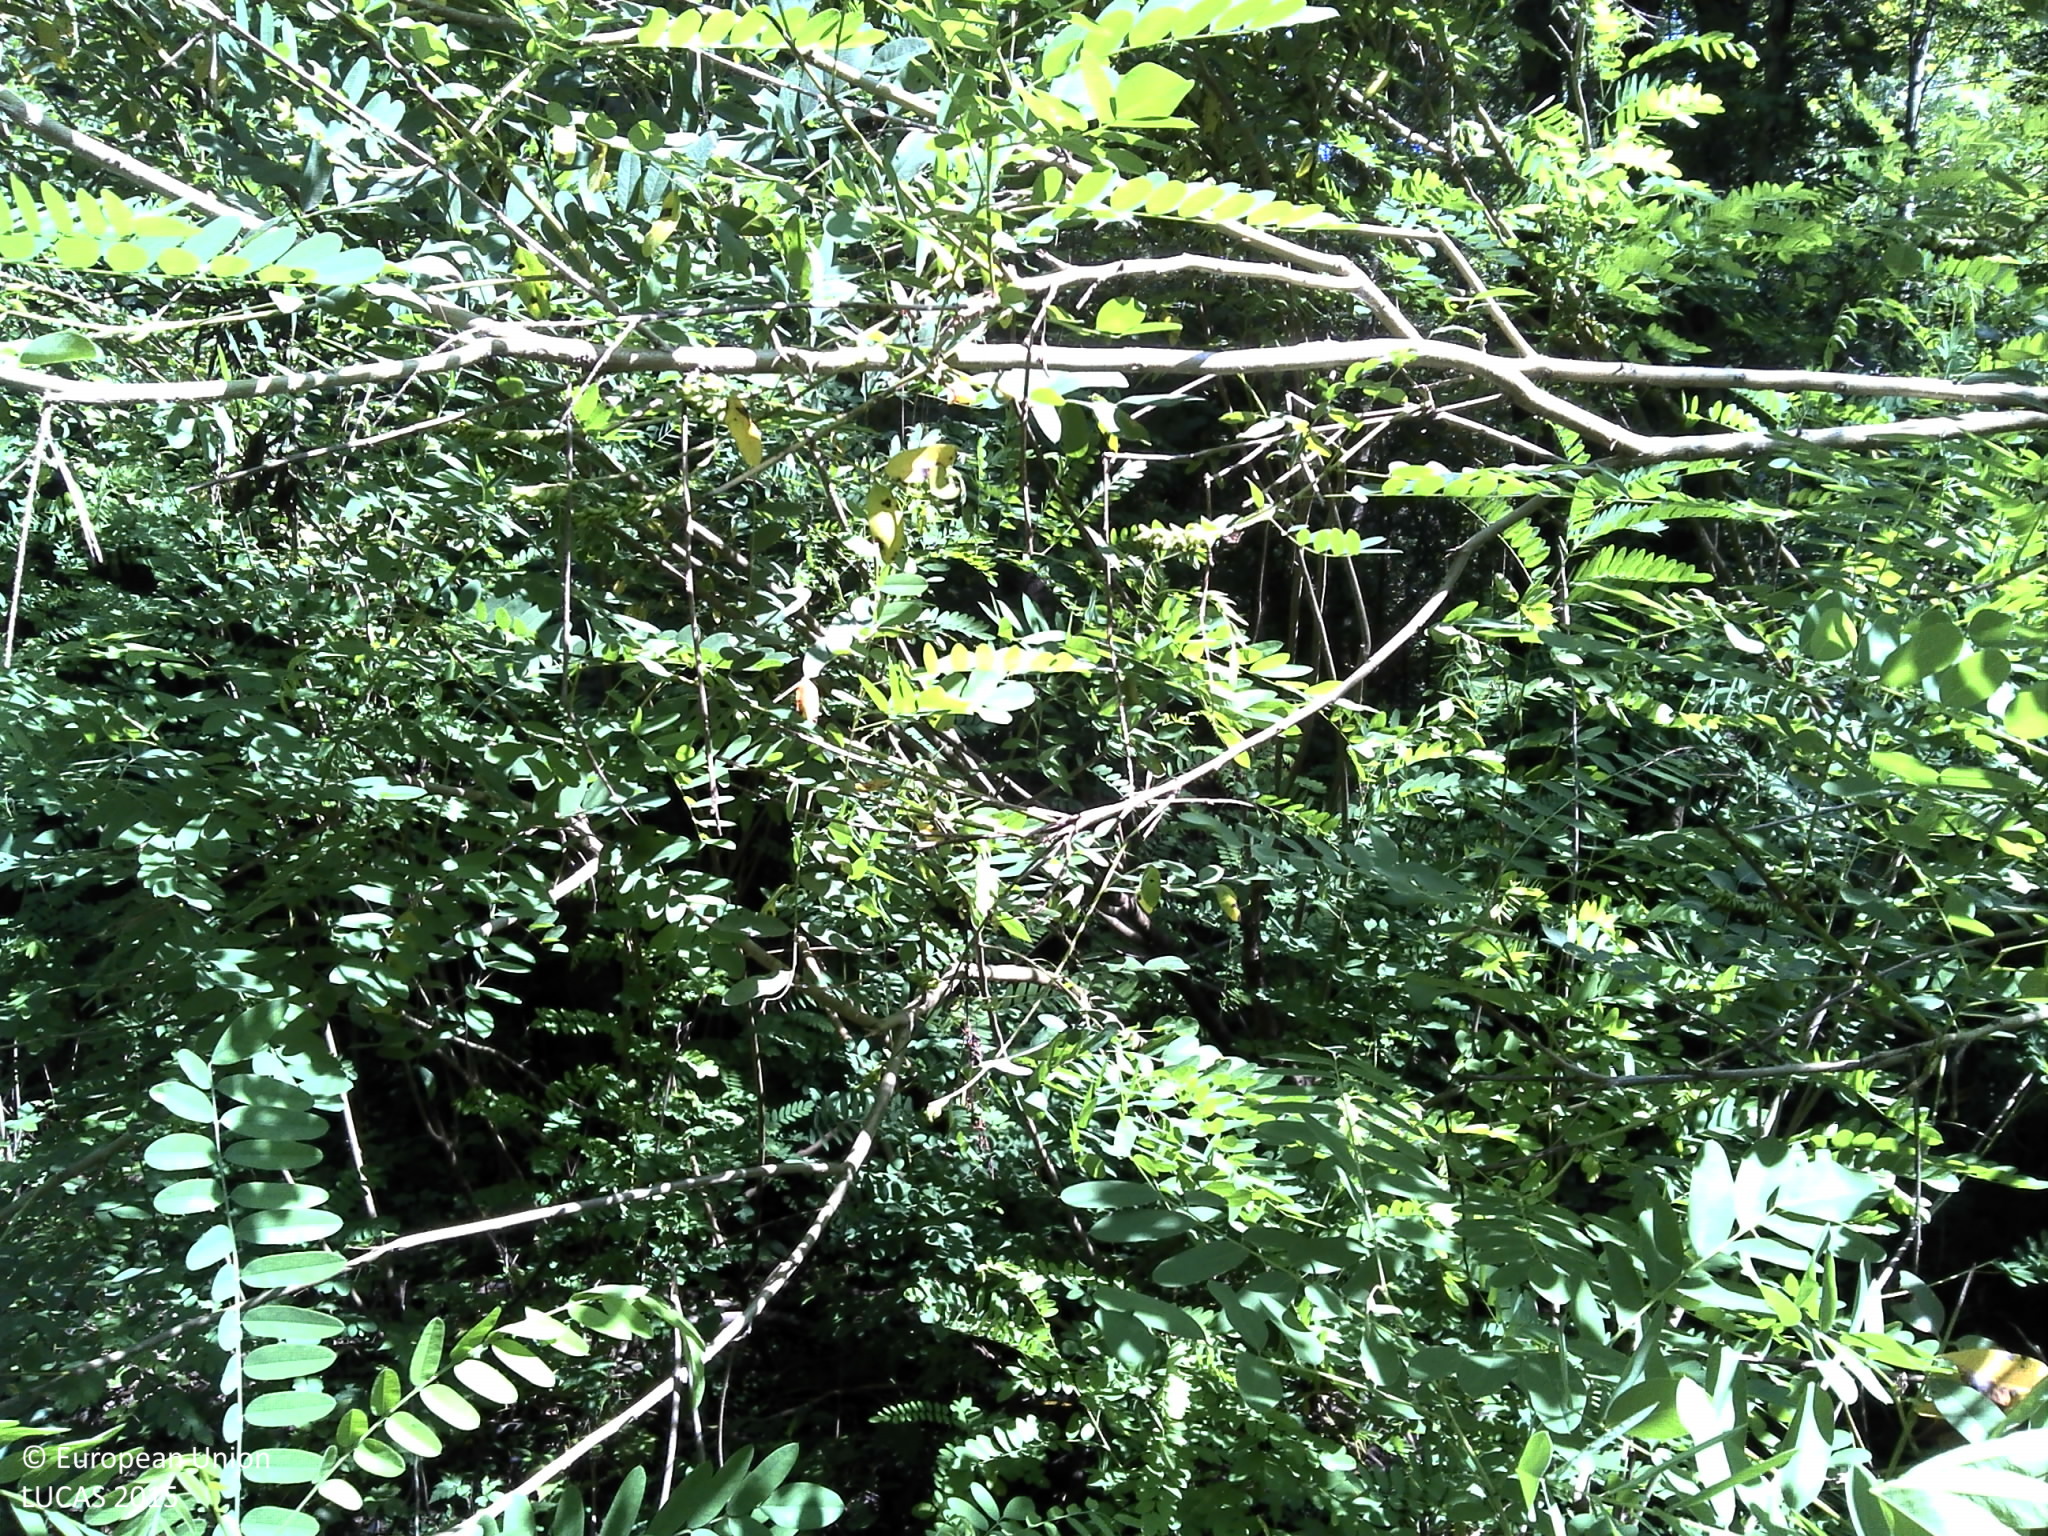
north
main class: Woodland
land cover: Broadleaved woodland
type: acidophilous oak and oak-birch forest
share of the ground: > 75 %
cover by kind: broadleaved forest trees 100 %
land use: Forestry
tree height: > 5 m
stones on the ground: < 10 %
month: August
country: HR
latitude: 45.4176
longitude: 16.7075
